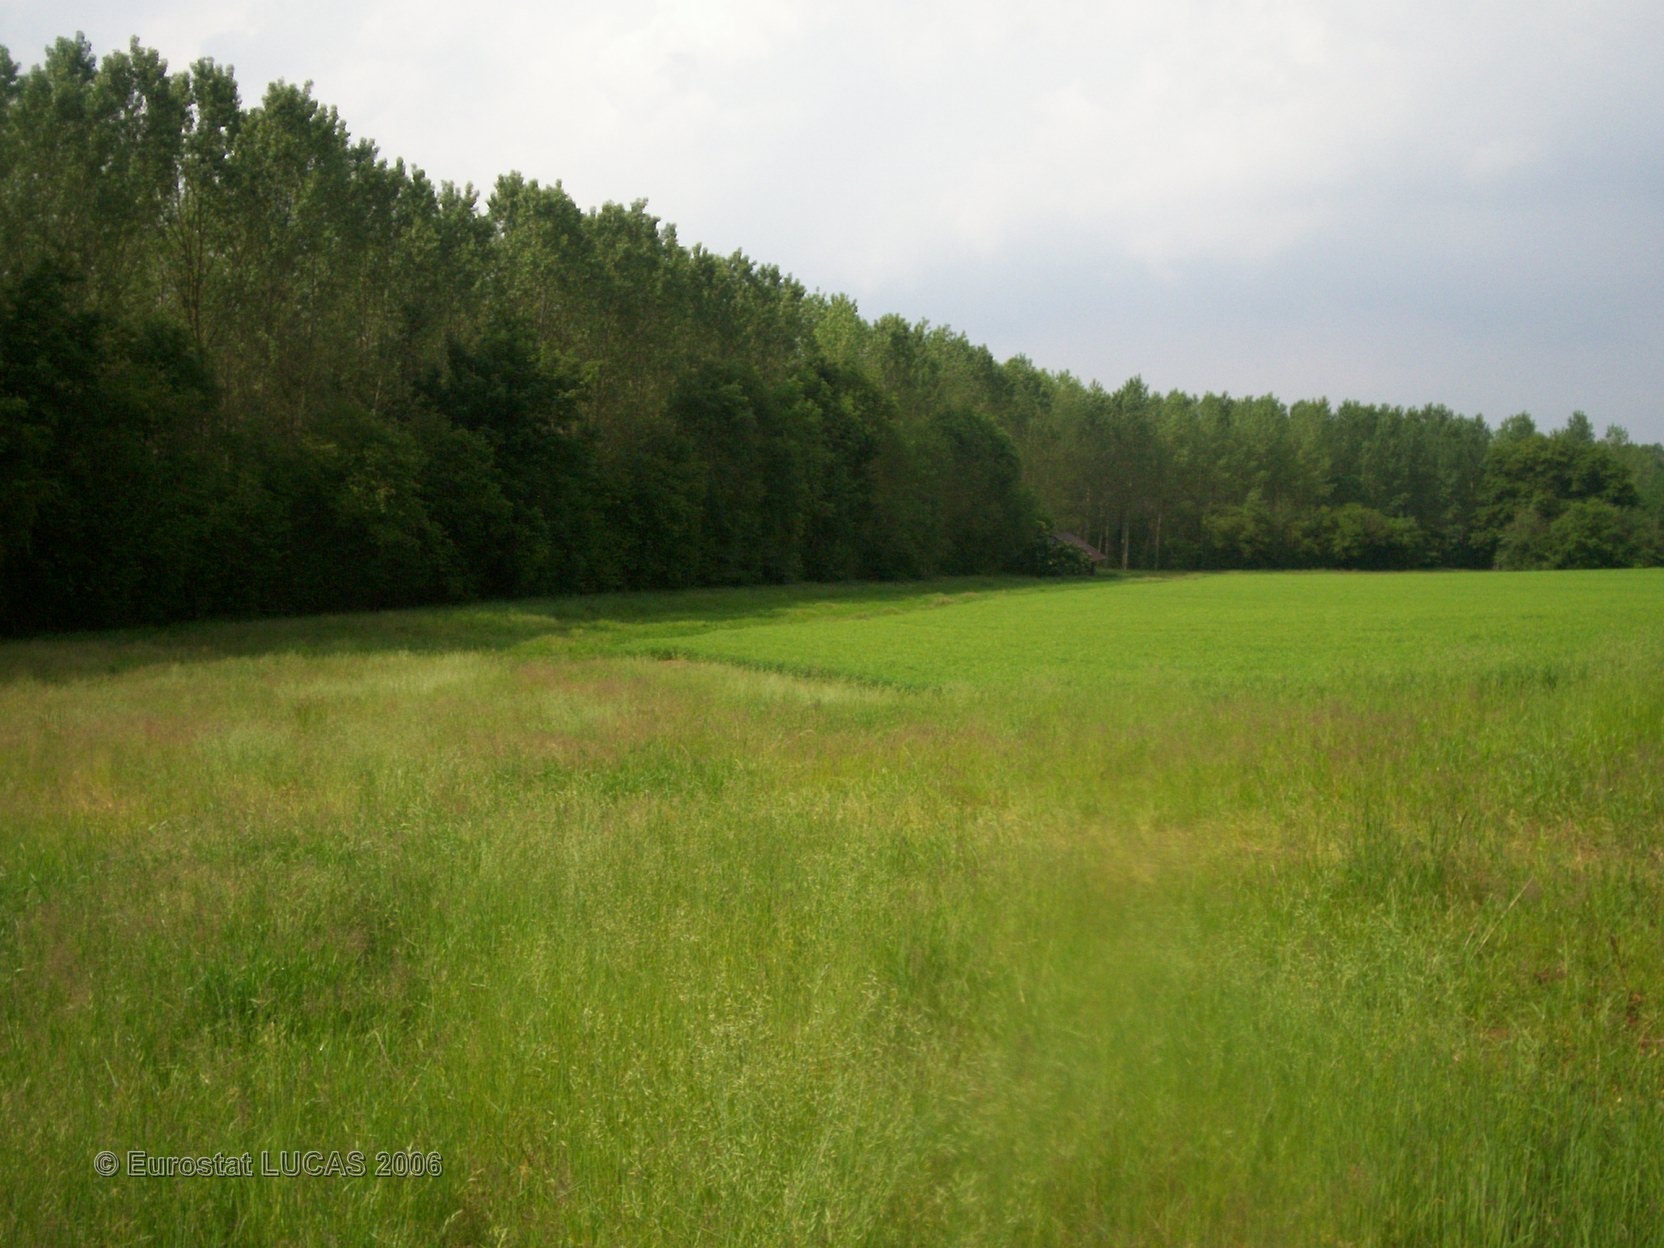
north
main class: Grassland
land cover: Grassland without tree/shrub cover
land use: Agriculture (excluding fallow land and kitchen gardens)
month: June
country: FR
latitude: 49.6962
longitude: 2.6827
